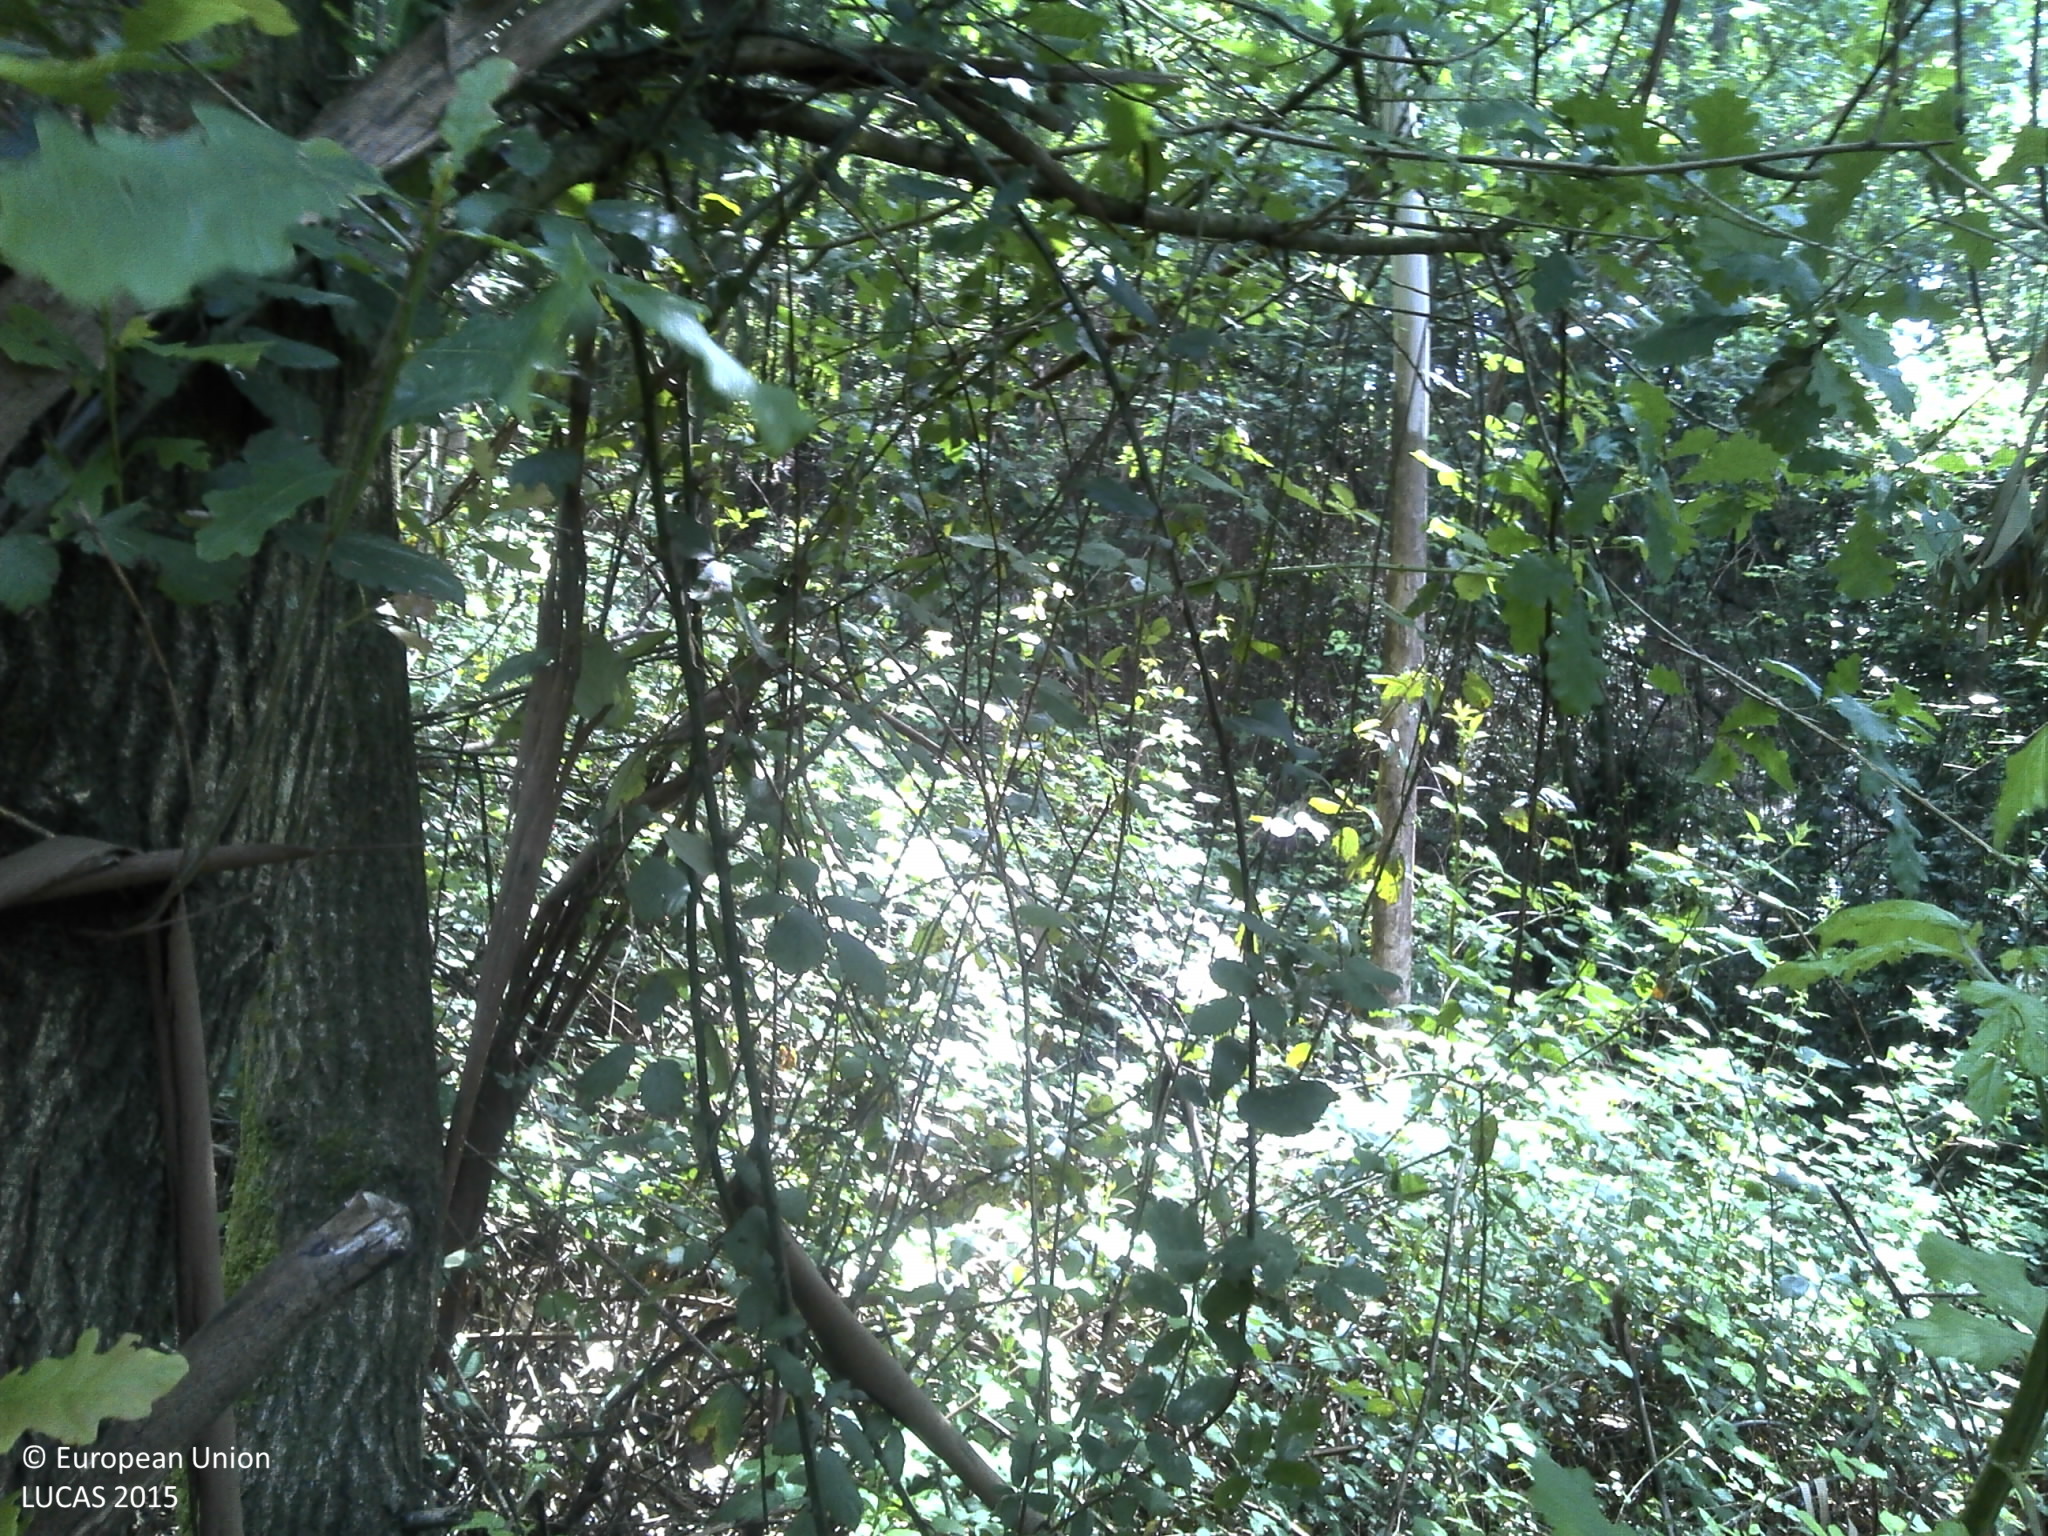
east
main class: Woodland
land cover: Broadleaved woodland
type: exotic forest
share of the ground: > 75 %
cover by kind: broadleaved forest trees 85 %, shrubs 10 %, unconsolidated bare surface 5 %
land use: Forestry
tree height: > 5 m
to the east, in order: Broadleaved woodland; Grass margins; Artificial constructions in urban areas; Broadleaved woodland; Shrubland without tree cover; Artificial constructions in urban areas; Potatoes
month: May
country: PT
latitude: 41.0816
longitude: -8.5888
